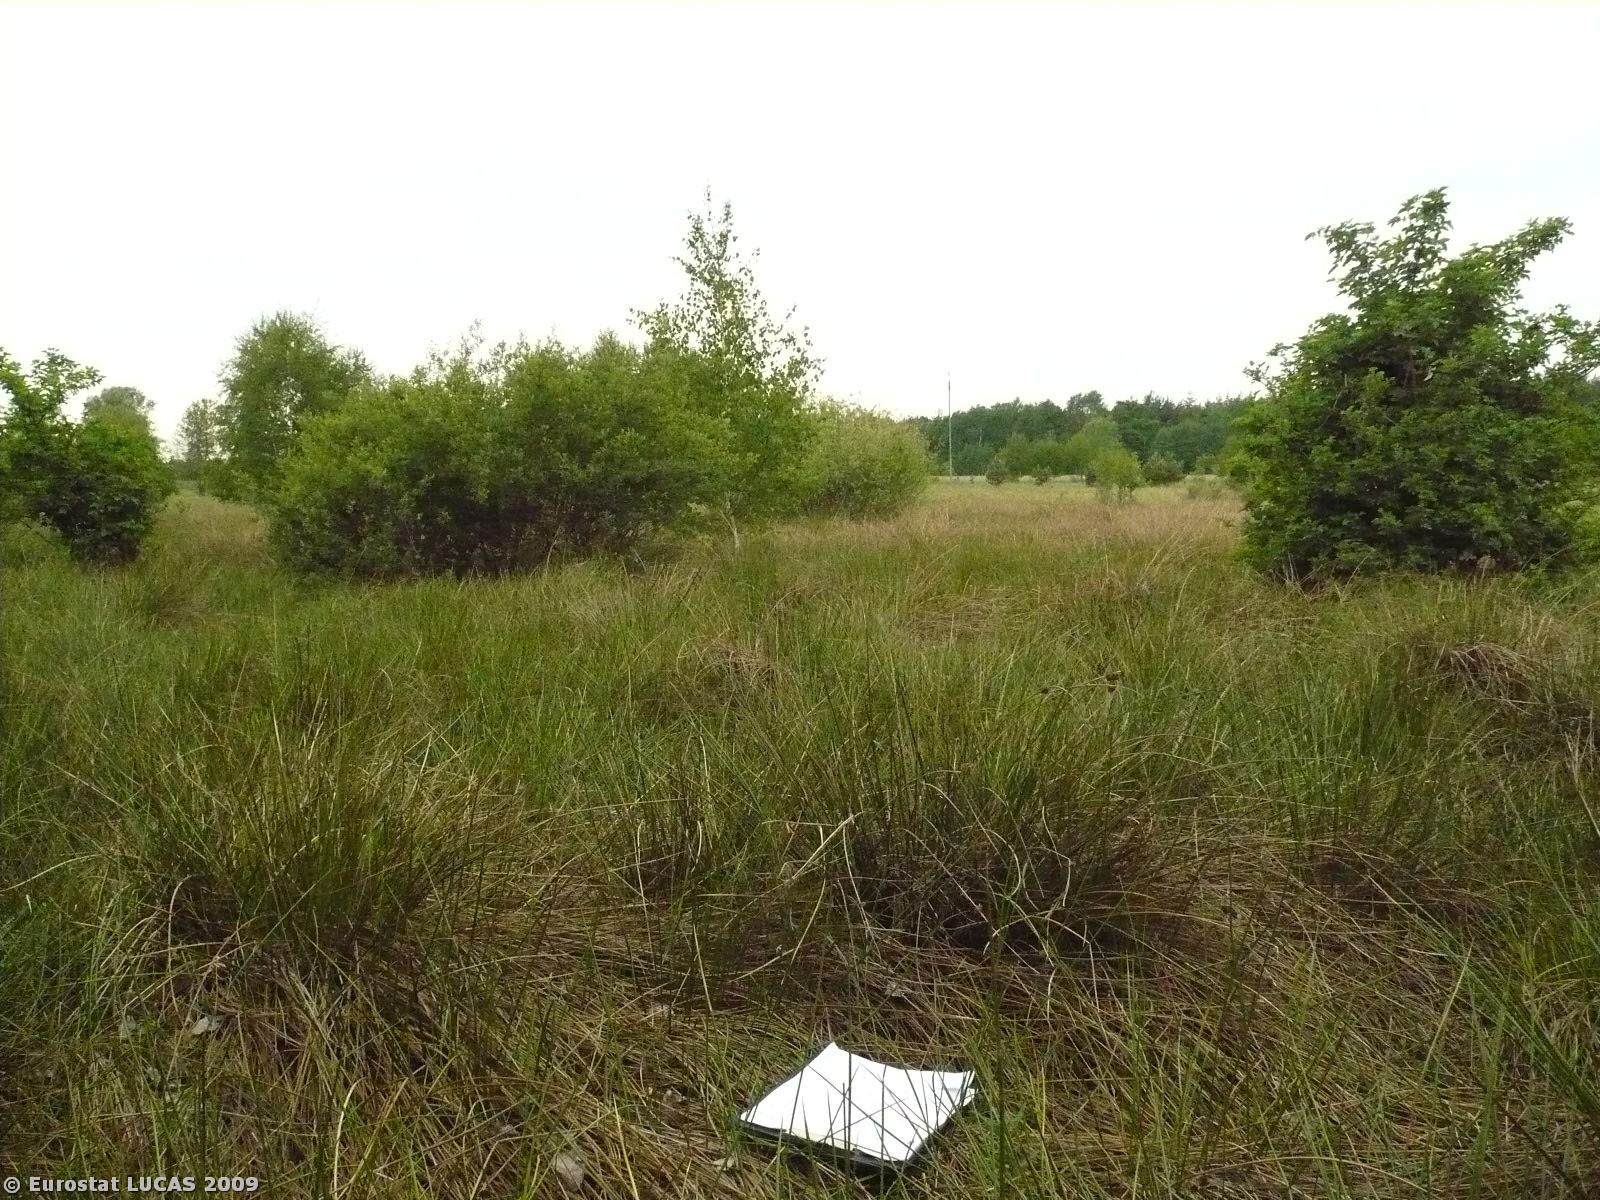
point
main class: Grassland
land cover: Grassland with sparse tree/shrub cover
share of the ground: > 75 %
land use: Unused
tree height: > 5 m
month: May
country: PL
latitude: 51.8089
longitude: 15.2975
